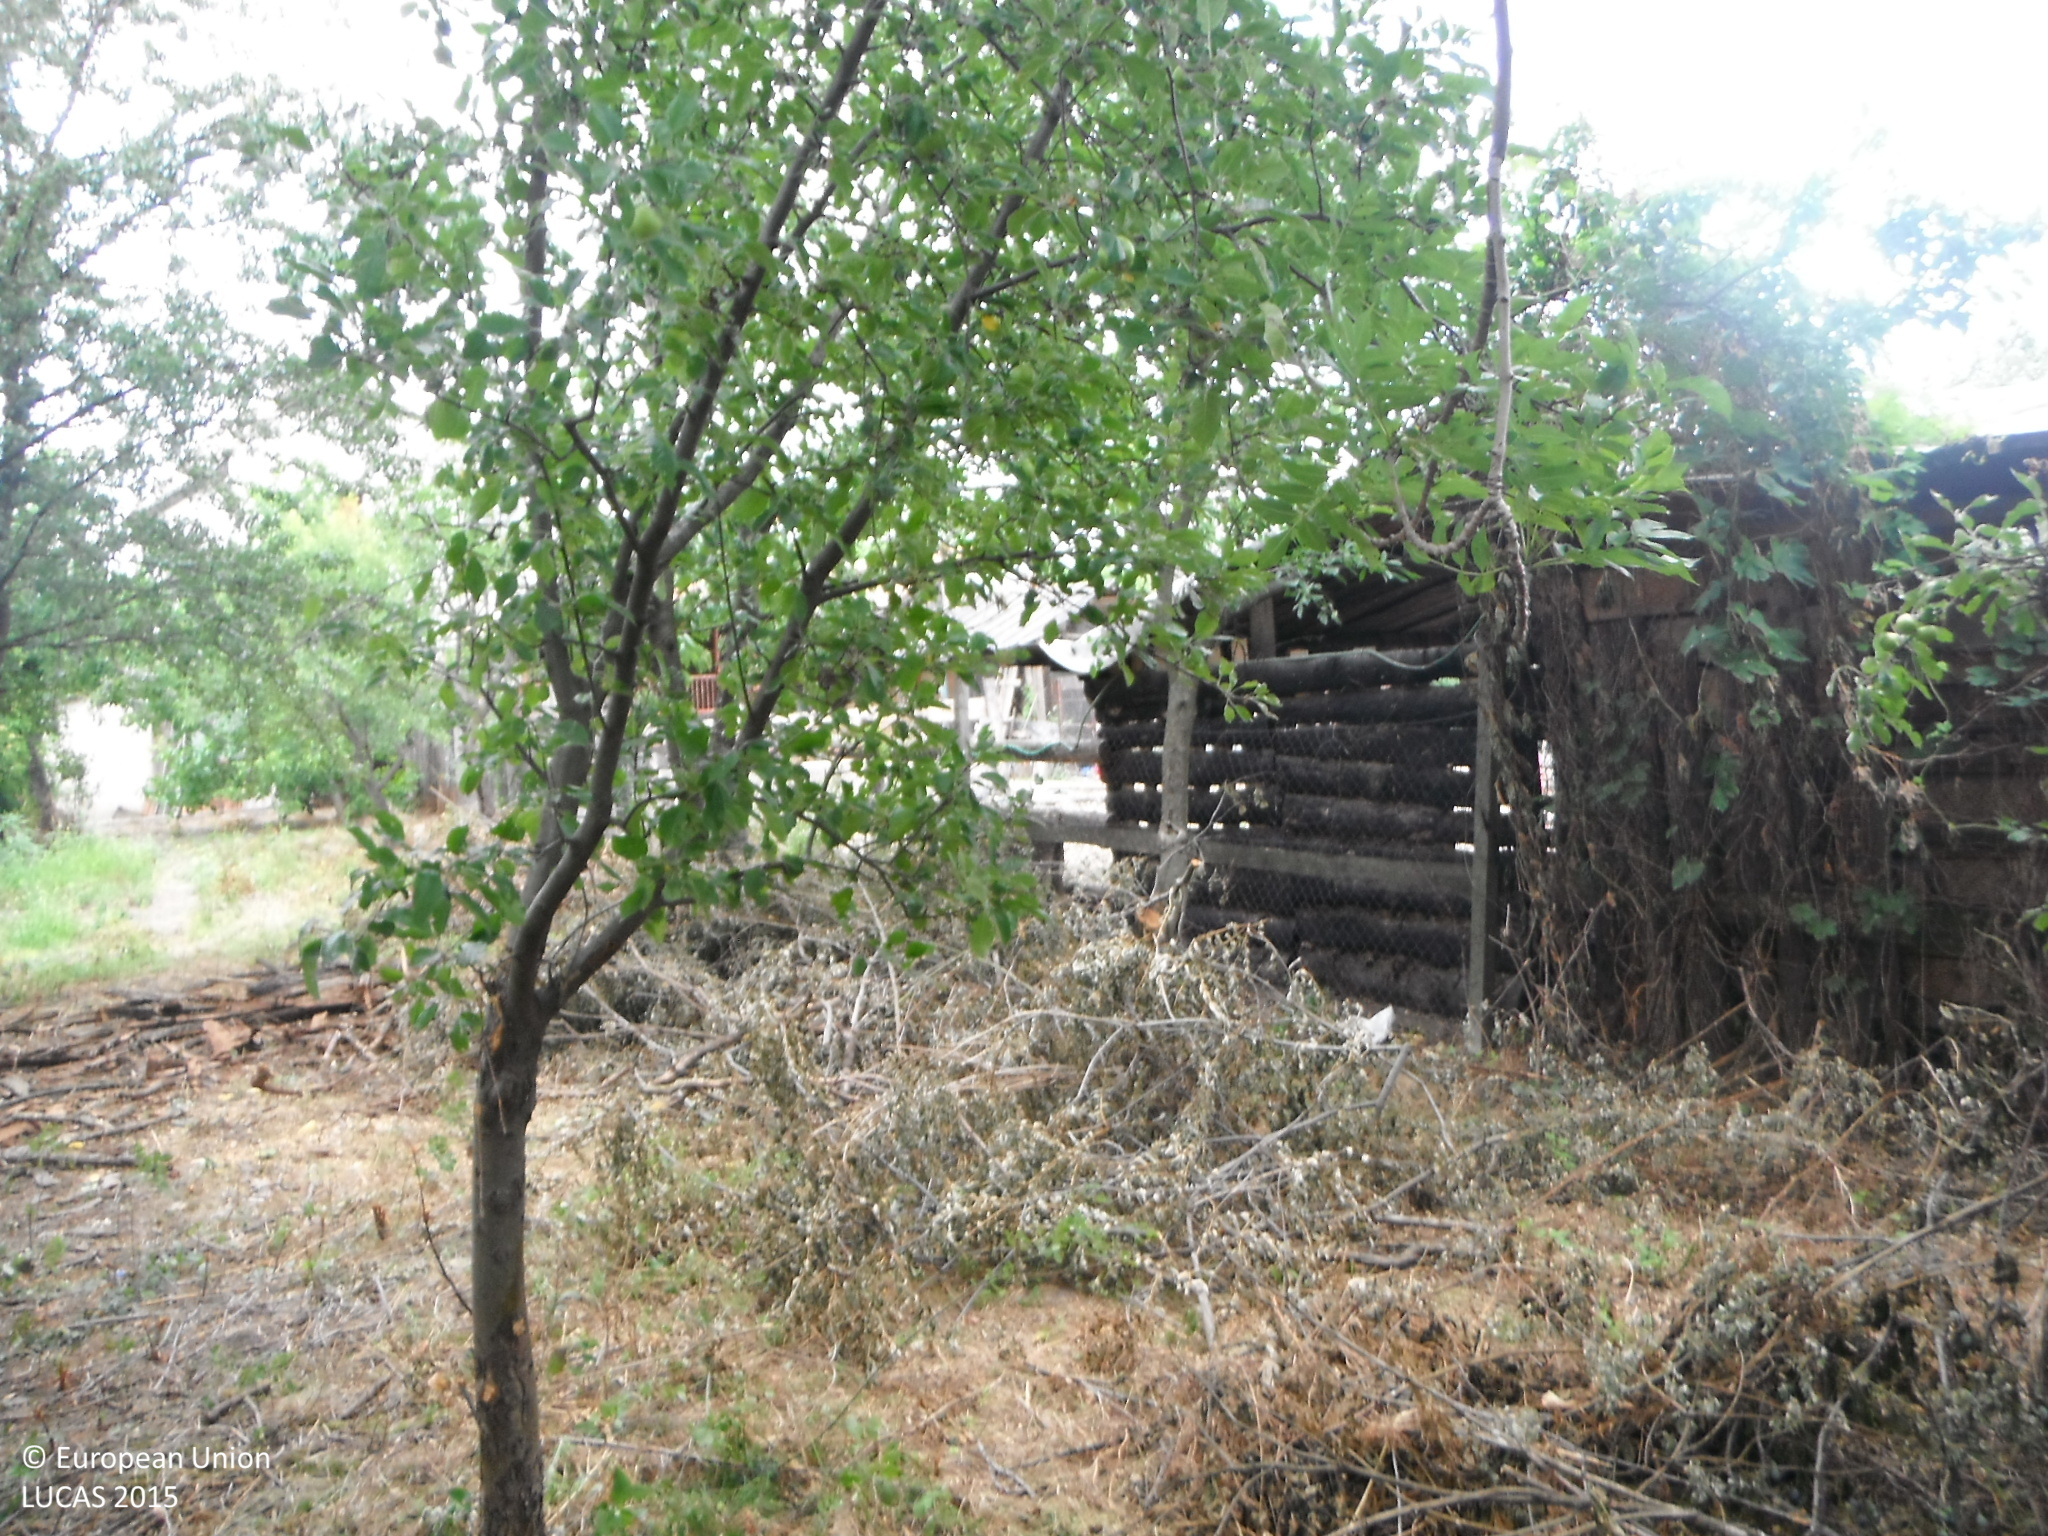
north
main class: Cropland
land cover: Other fruit trees and berries
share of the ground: 10 - 25 %
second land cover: Grassland without tree/shrub cover
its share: > 75 %
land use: Kitchen garden
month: July
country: SK
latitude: 48.4844
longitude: 18.1184
